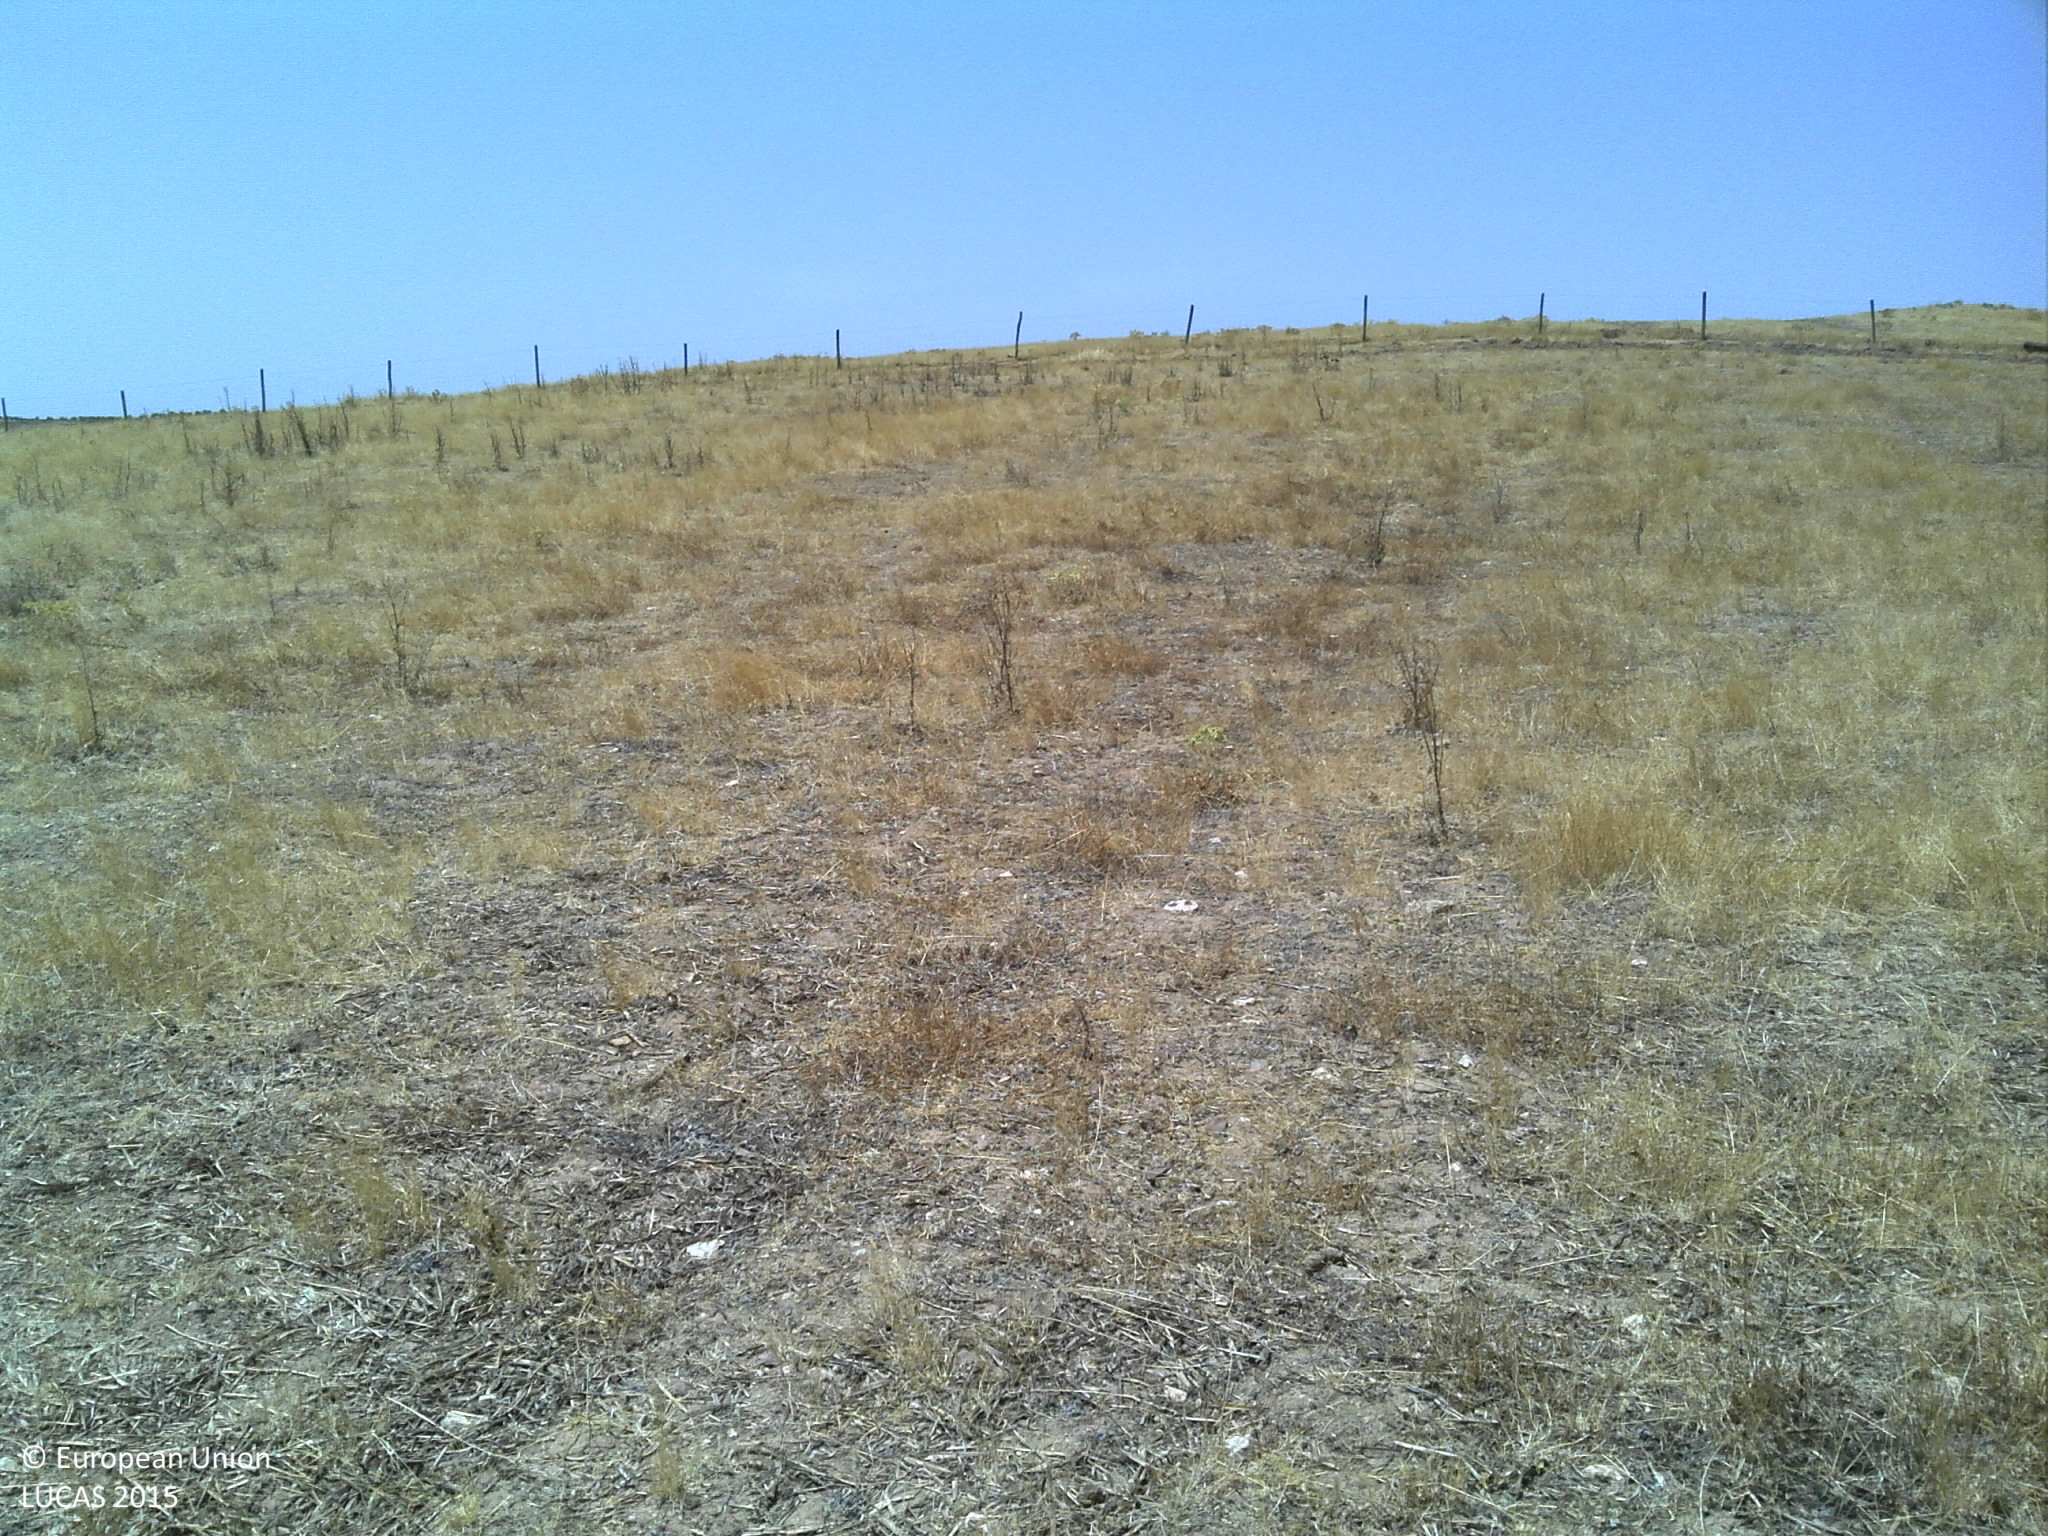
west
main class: Grassland
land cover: Grassland without tree/shrub cover
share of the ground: 10 - 25 %
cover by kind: unconsolidated bare surface 75 %, herbaceous plants 25 %
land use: Agriculture (excluding fallow land and kitchen gardens)
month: July
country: PT
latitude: 37.7018
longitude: -7.7929
